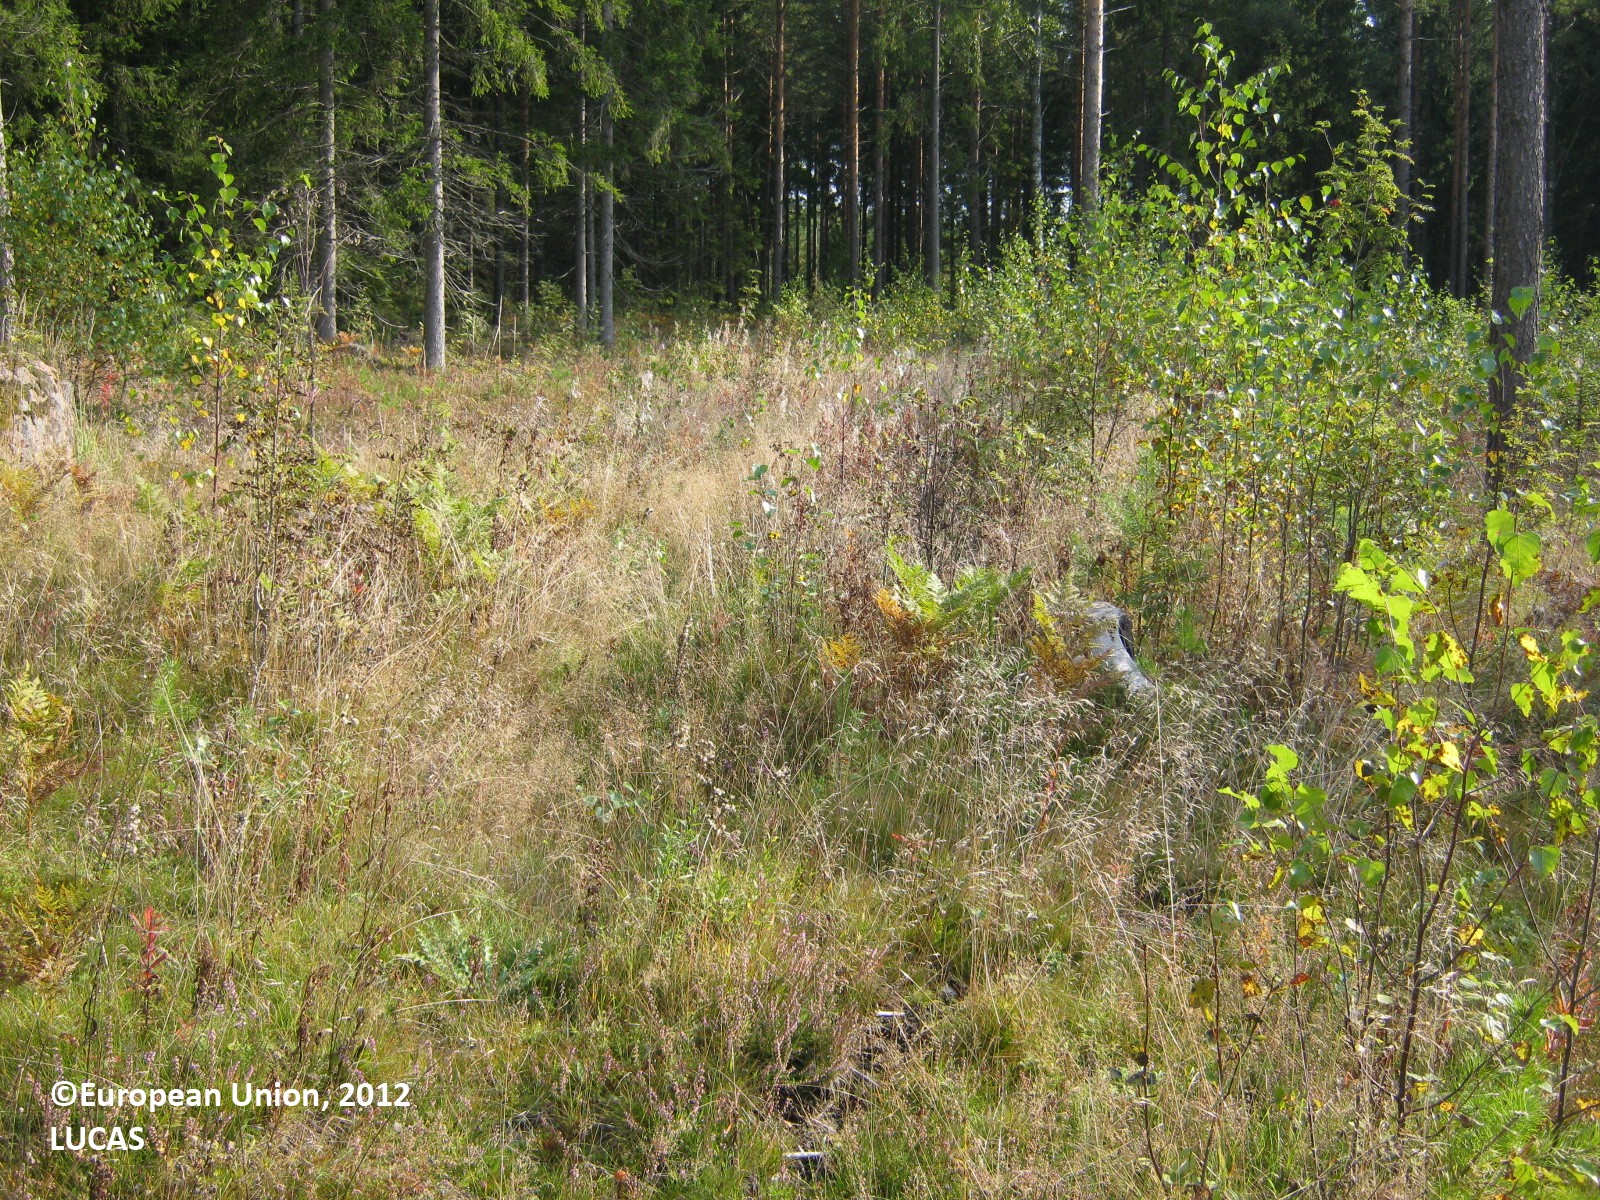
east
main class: Woodland
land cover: Broadleaved woodland
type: boreal forest
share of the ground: 25 - 50 %
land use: Forestry
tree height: < 5 m
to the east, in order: Broadleaved woodland; Spruce dominated coniferous woodland
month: September
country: FI
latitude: 60.5285
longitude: 27.7039
